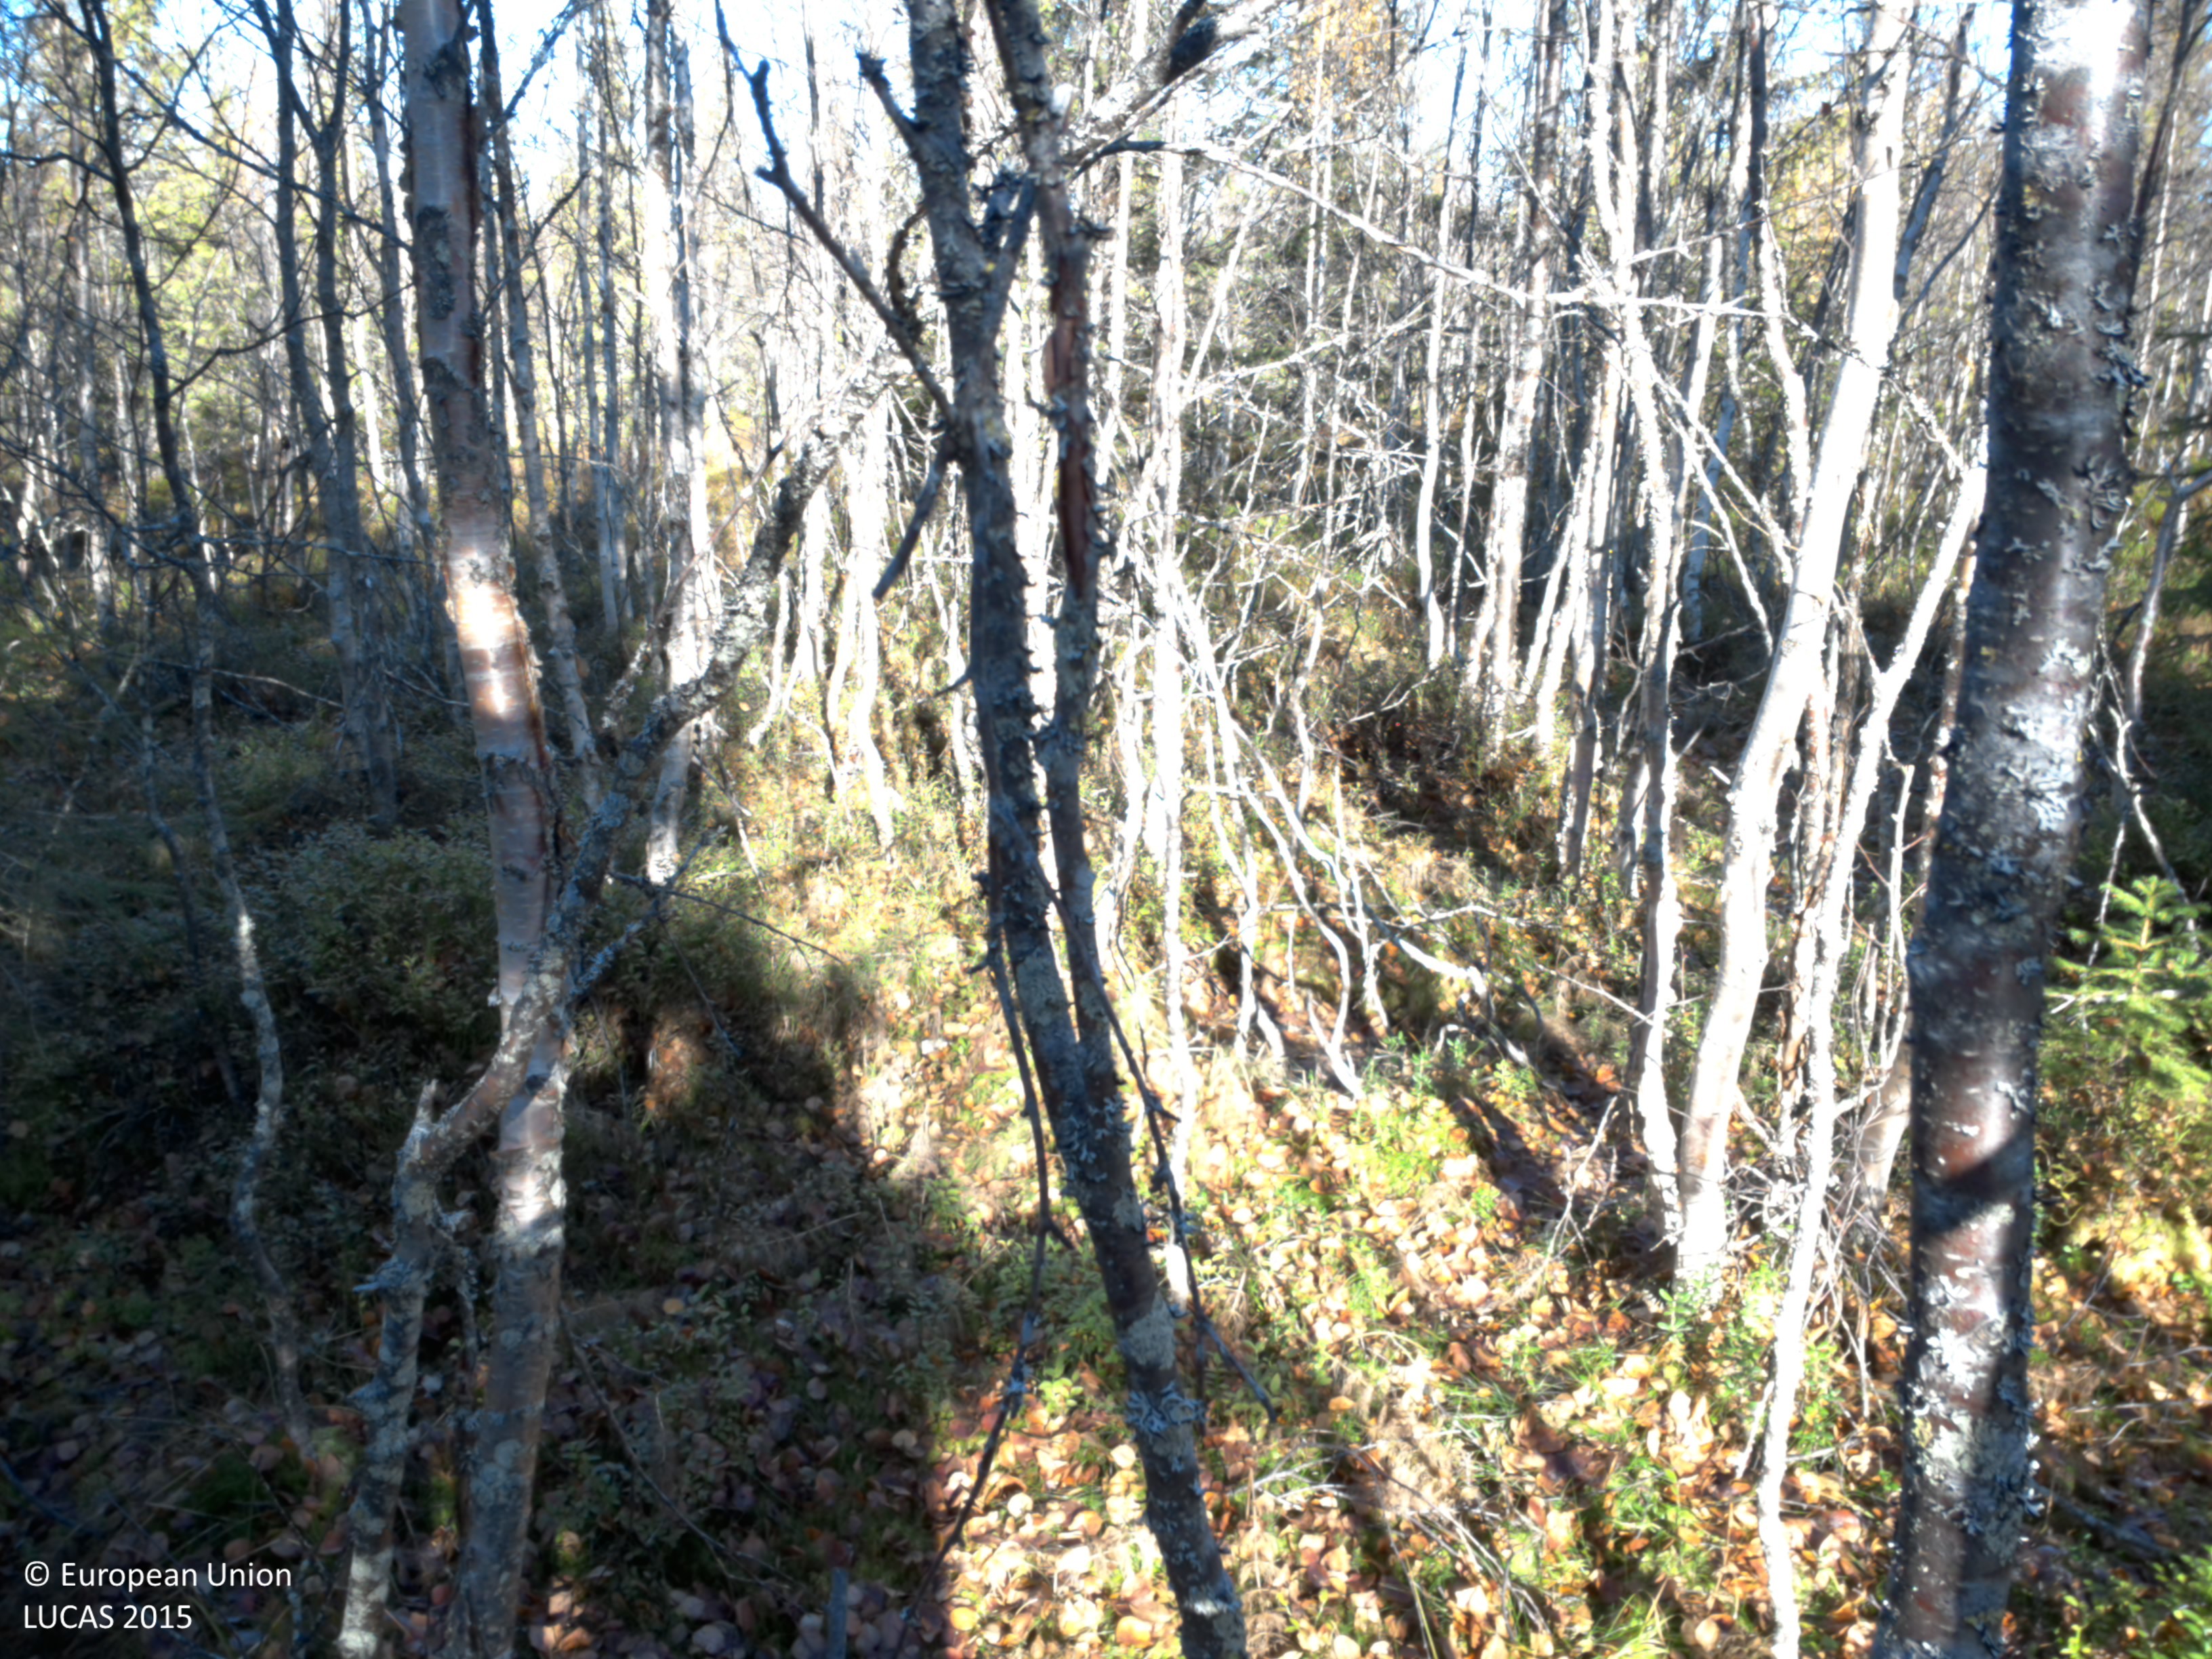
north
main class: Woodland
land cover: Spruce dominated mixed woodland
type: boreal forest
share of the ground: > 75 %
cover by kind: broadleaved forest trees 50 %, coniferous forest trees 30 %, shrubs 10 %, herbaceous plants 5 %, lichens and mosses 5 %
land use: Forestry
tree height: > 5 m
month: October
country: SE
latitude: 64.6076
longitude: 17.7625
